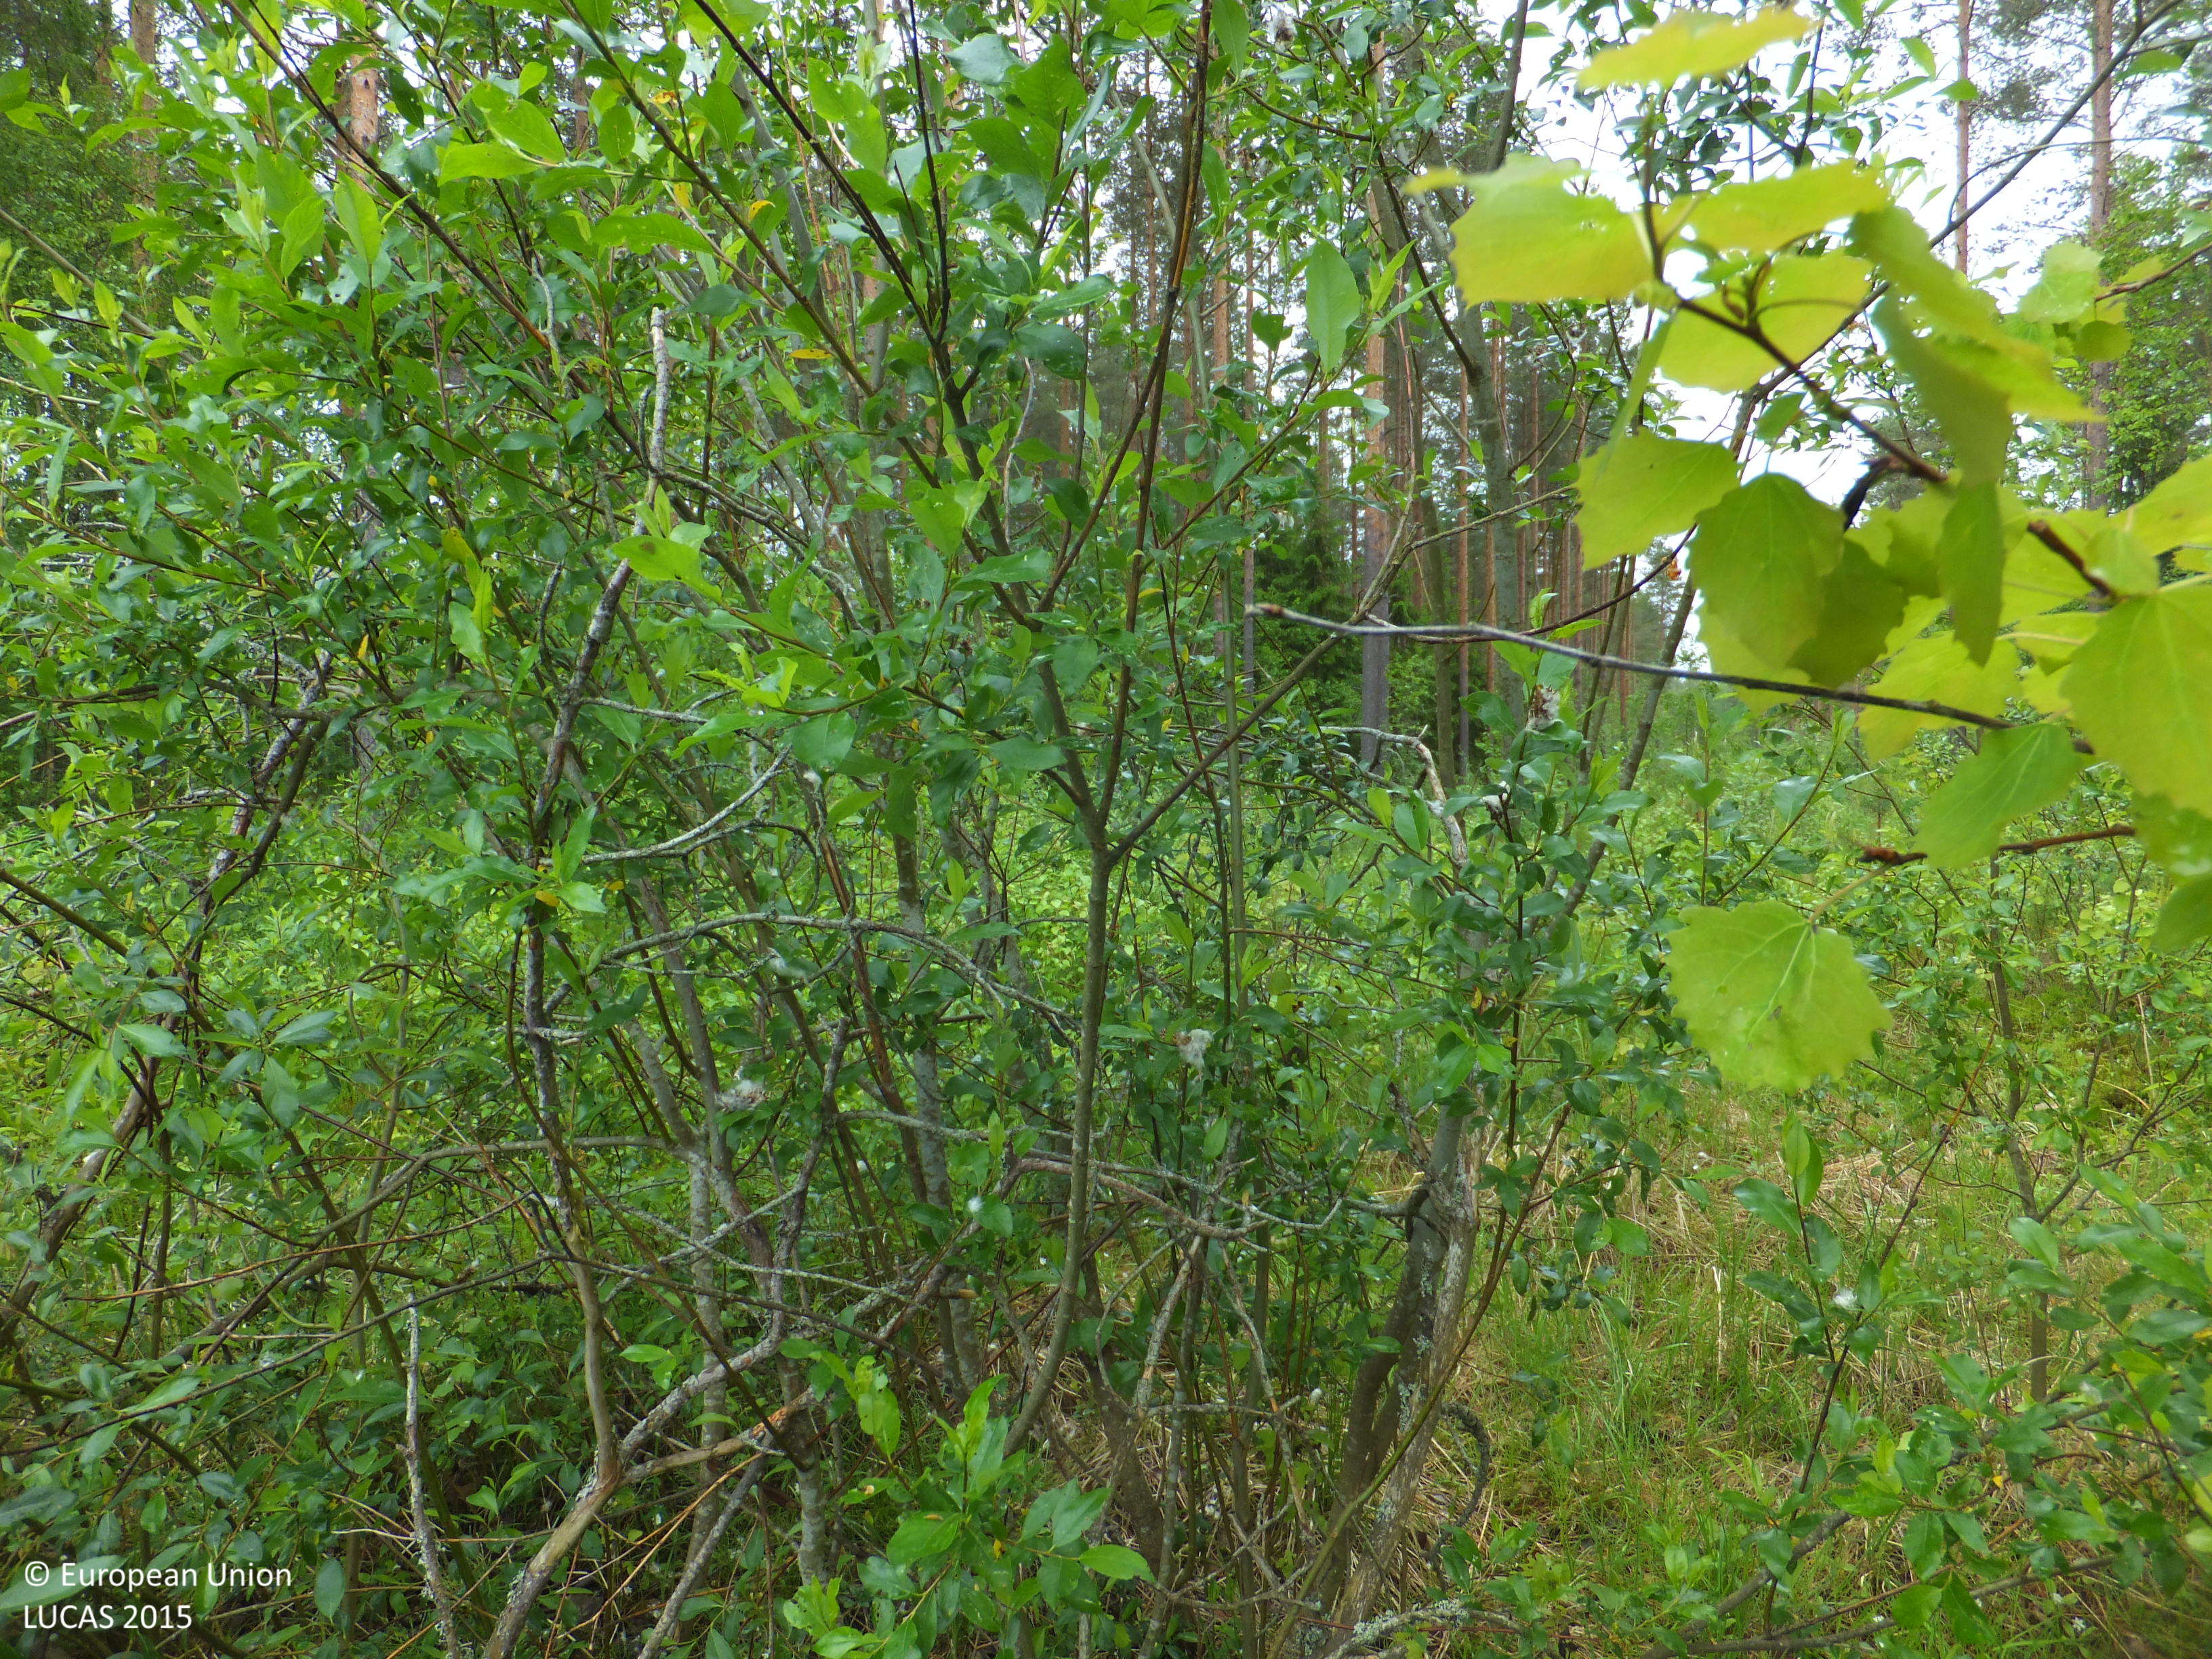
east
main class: Woodland
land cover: Pine dominated mixed woodland
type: boreal forest
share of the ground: > 75 %
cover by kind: coniferous forest trees 55 %, broadleaved forest trees 20 %, shrubs 15 %, herbaceous plants 5 %, lichens and mosses 5 %
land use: Forestry
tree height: > 5 m
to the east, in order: Pine dominated mixed woodland; Grass margins; Ditches and canals; Pine dominated mixed woodland; Ditches and canals; Barley; Abandoned hedges; Ditches and canals; Temporary grasslands
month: June
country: FI
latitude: 63.4563
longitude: 23.8475
